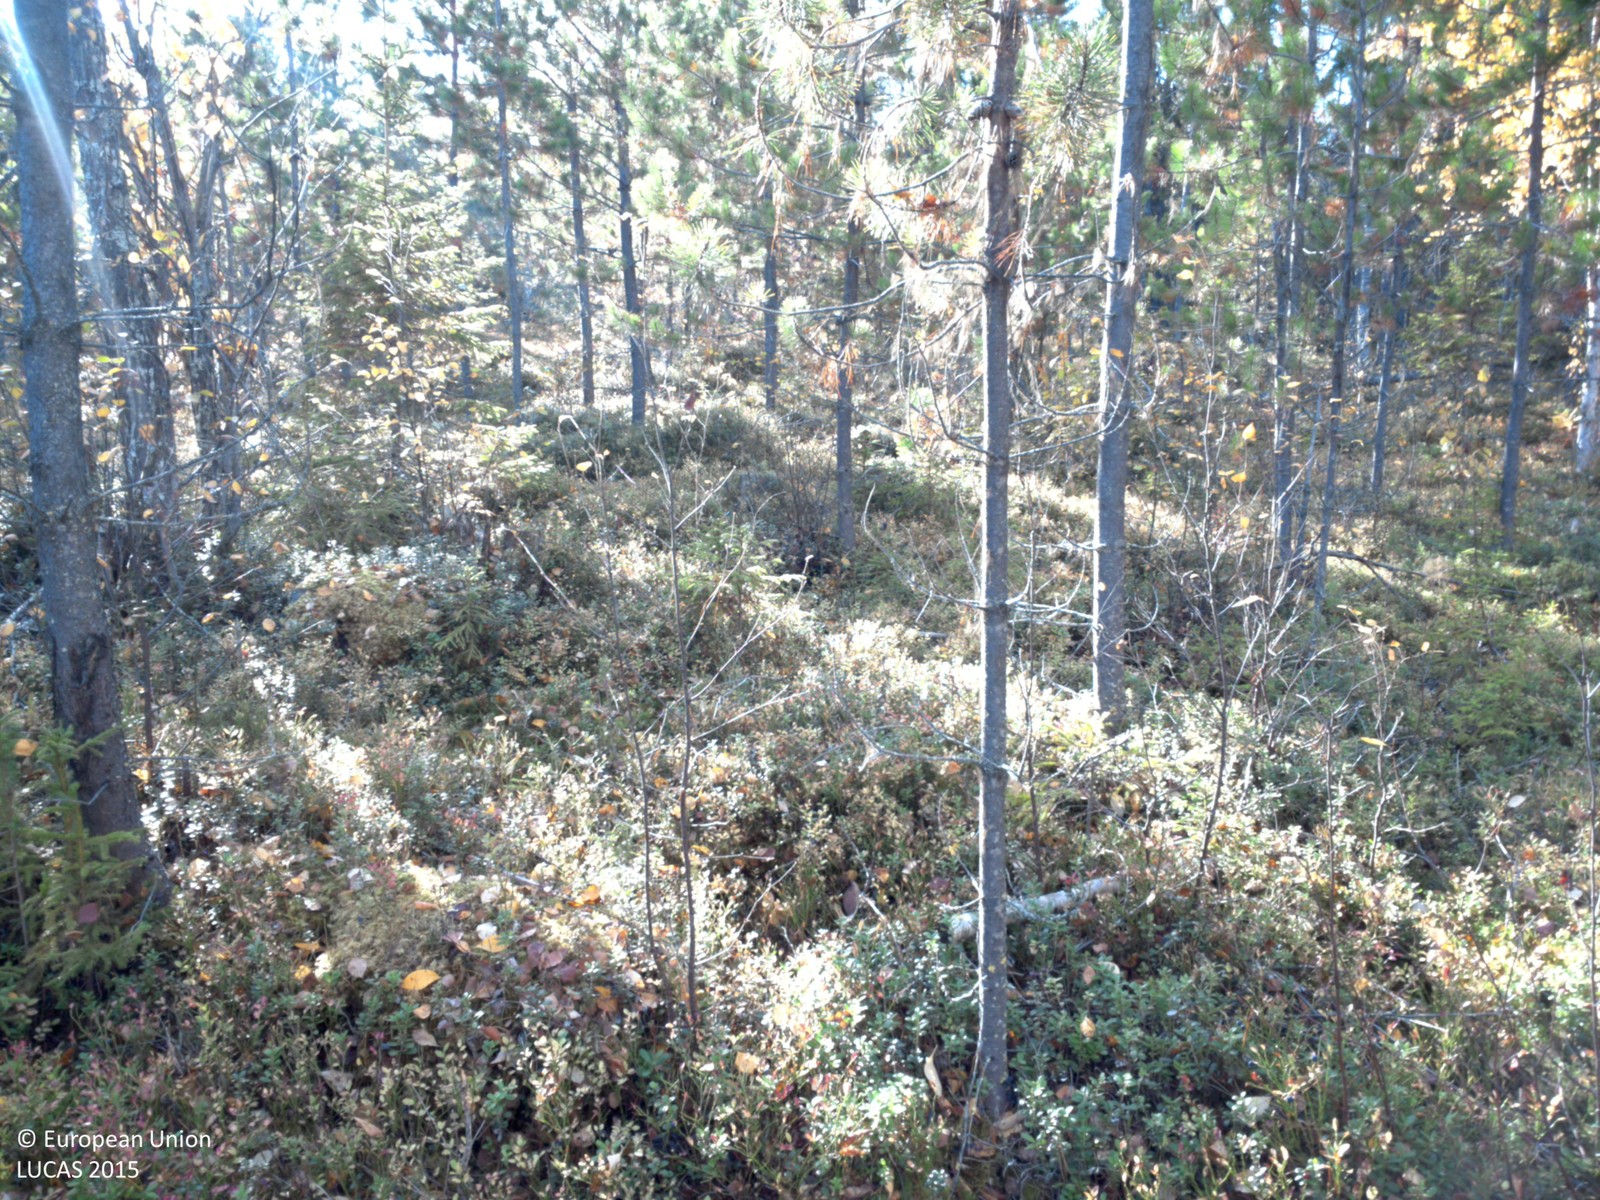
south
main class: Woodland
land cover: Other mixed woodland
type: boreal forest
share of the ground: 50 - 75 %
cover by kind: coniferous forest trees 45 %, shrubs 40 %, broadleaved forest trees 15 %
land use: Forestry
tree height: > 5 m
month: September
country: SE
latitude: 64.8069
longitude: 18.4931
